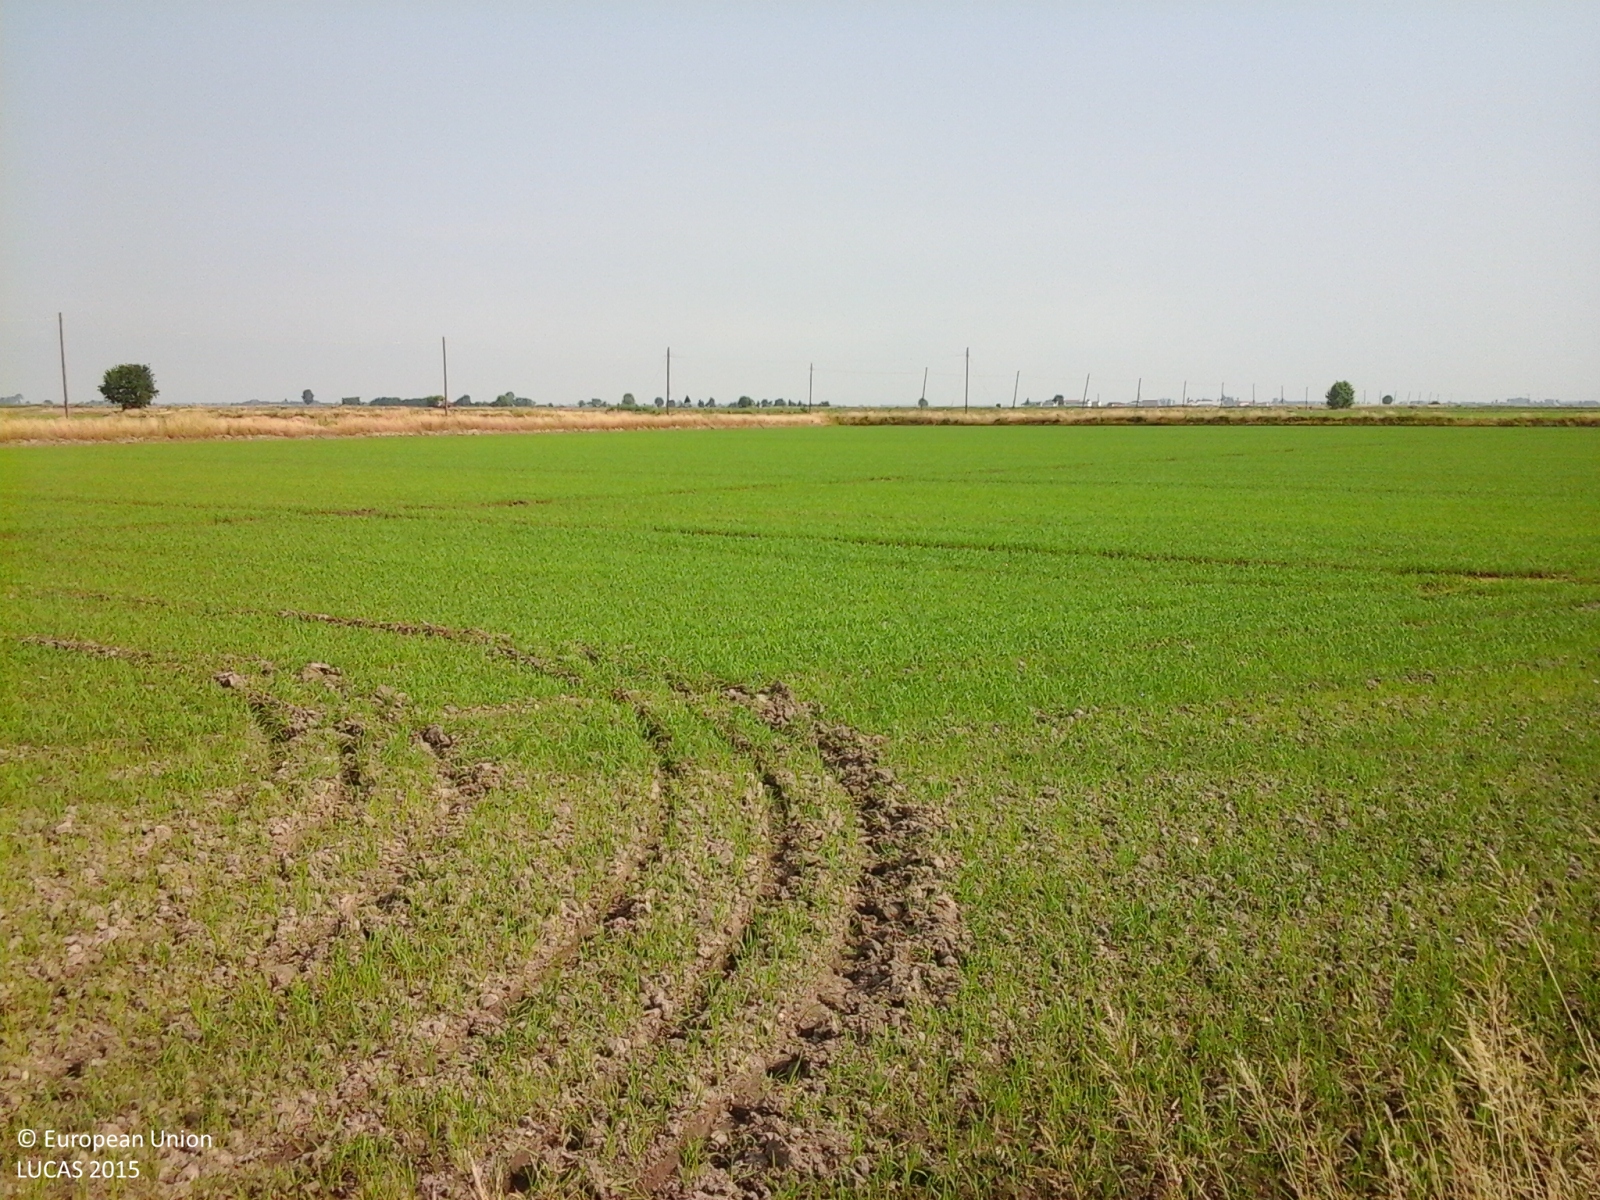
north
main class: Cropland
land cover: Rice
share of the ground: 25 - 50 %
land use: Agriculture (excluding fallow land and kitchen gardens)
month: May
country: IT
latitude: 45.2561
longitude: 8.2827
